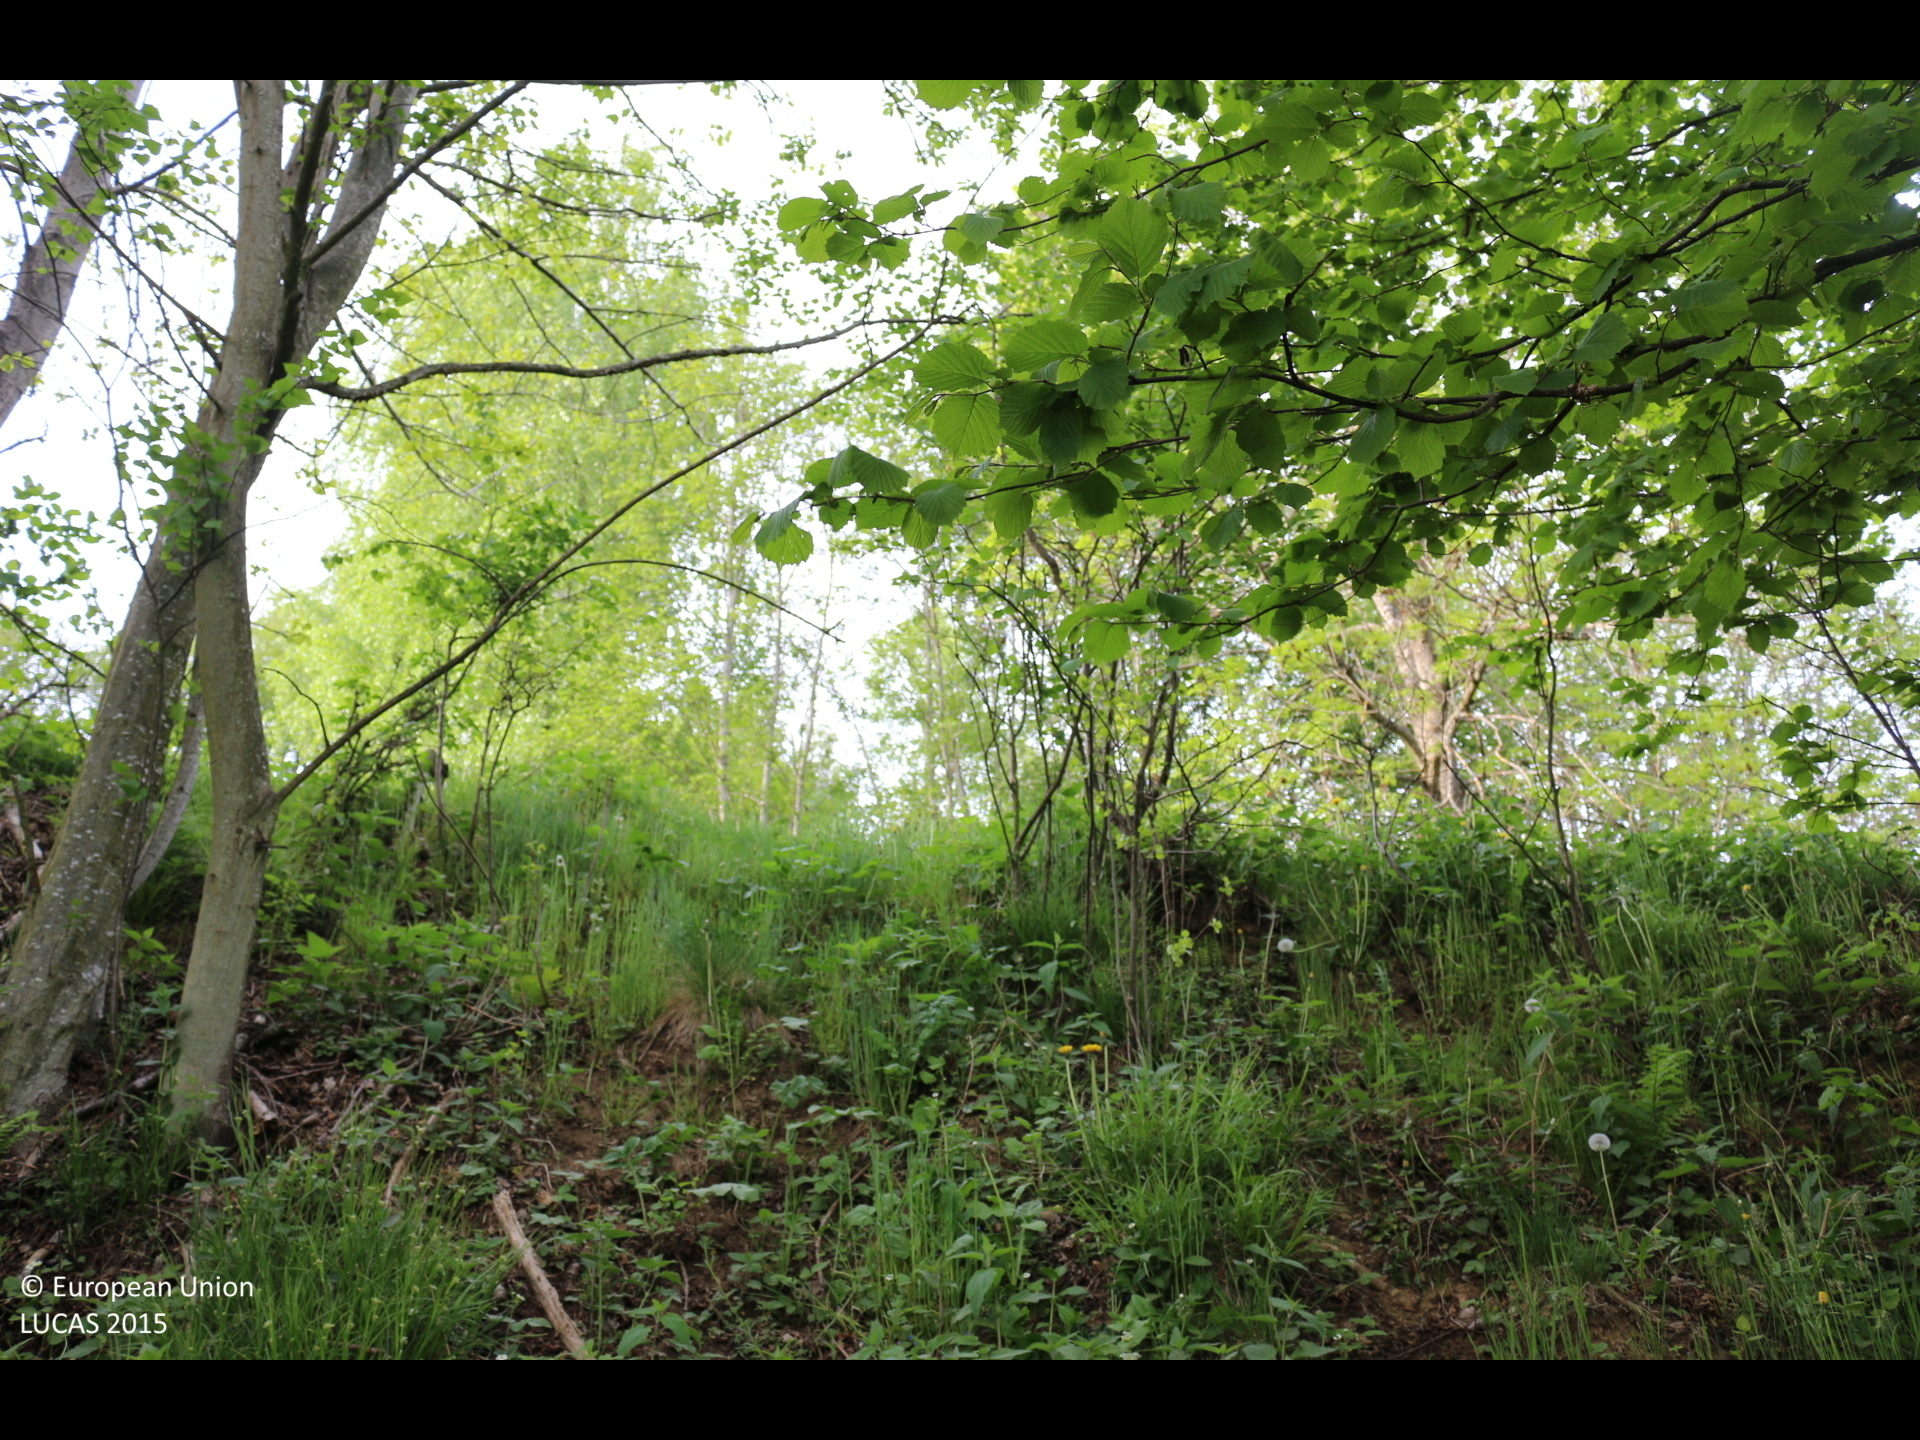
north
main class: Woodland
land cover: Broadleaved woodland
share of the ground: > 75 %
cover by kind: broadleaved forest trees 90 %, shrubs 5 %, herbaceous plants 5 %
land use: Forestry
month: May
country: AT
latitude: 46.7757
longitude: 14.1492
